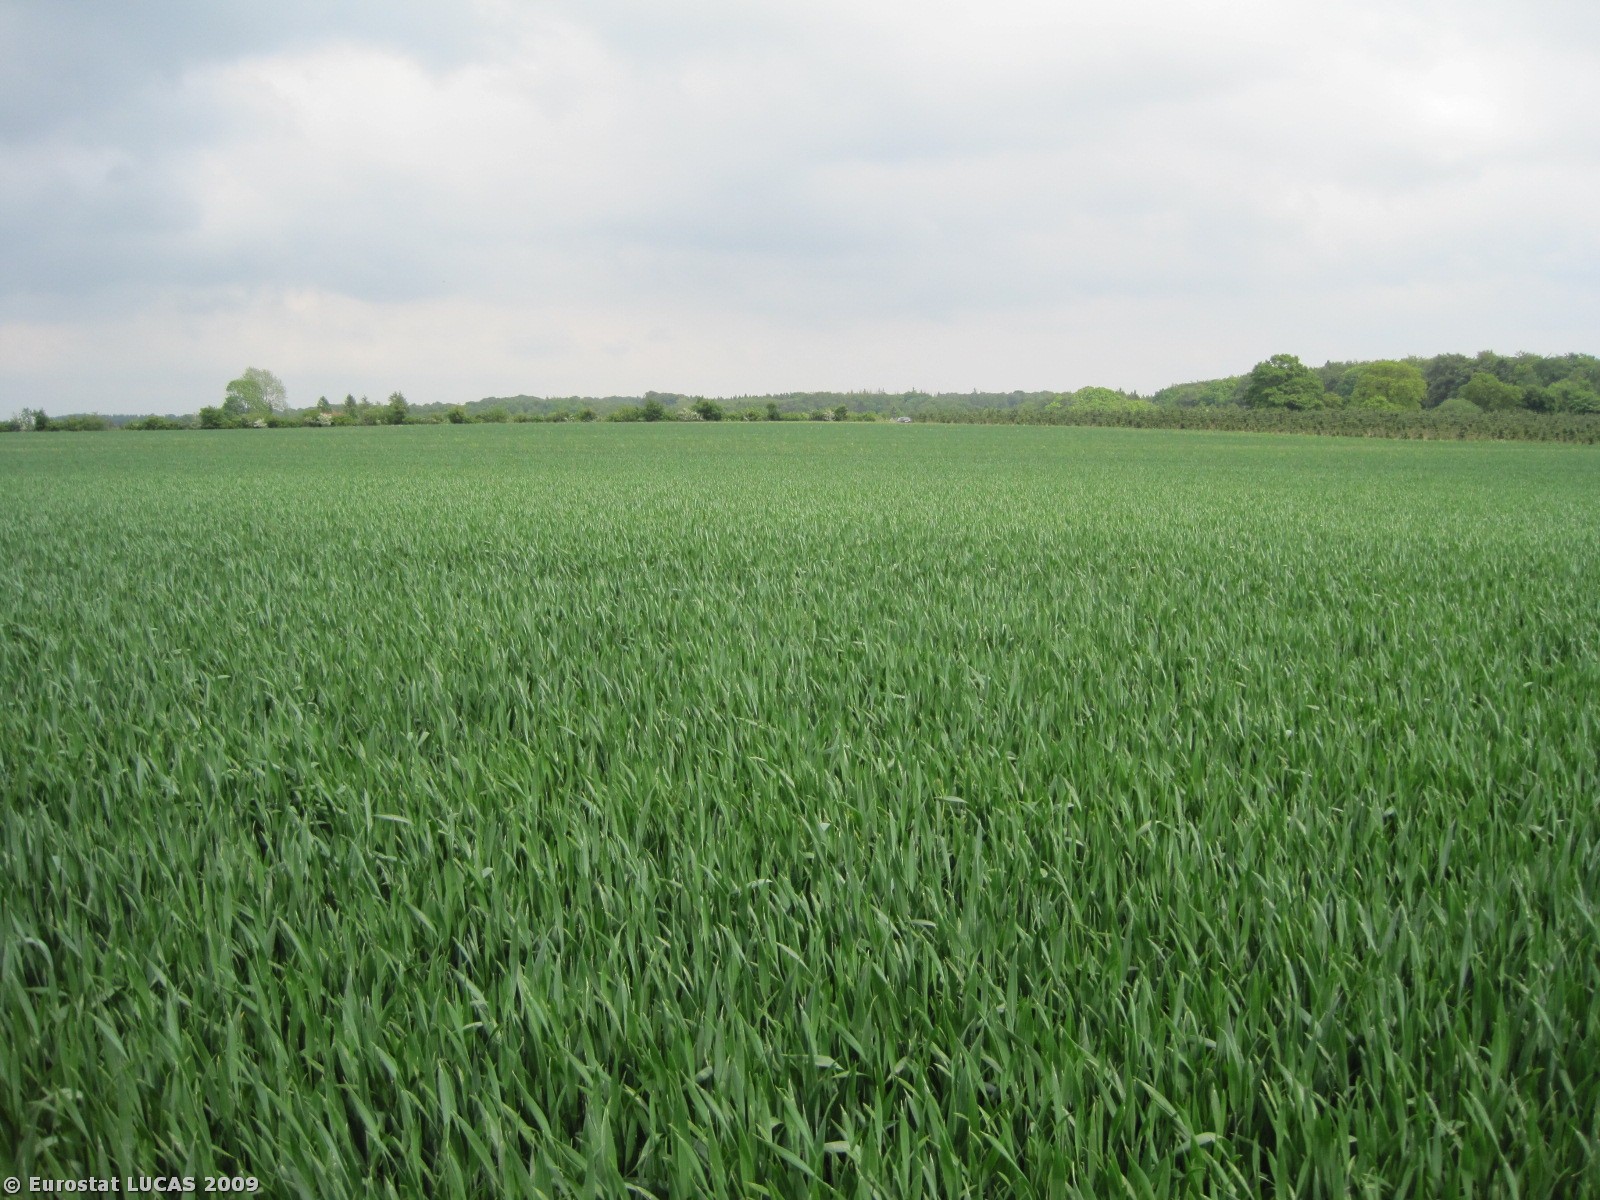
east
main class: Cropland
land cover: Common wheat
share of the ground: 50 - 75 %
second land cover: Oats
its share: 10 - 25 %
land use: Agriculture (excluding fallow land and kitchen gardens)
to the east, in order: Common wheat; Grass margins; Broadleaved woodland; Fences; Coniferous woodland
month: May
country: DK
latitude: 56.4572
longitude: 9.7893
